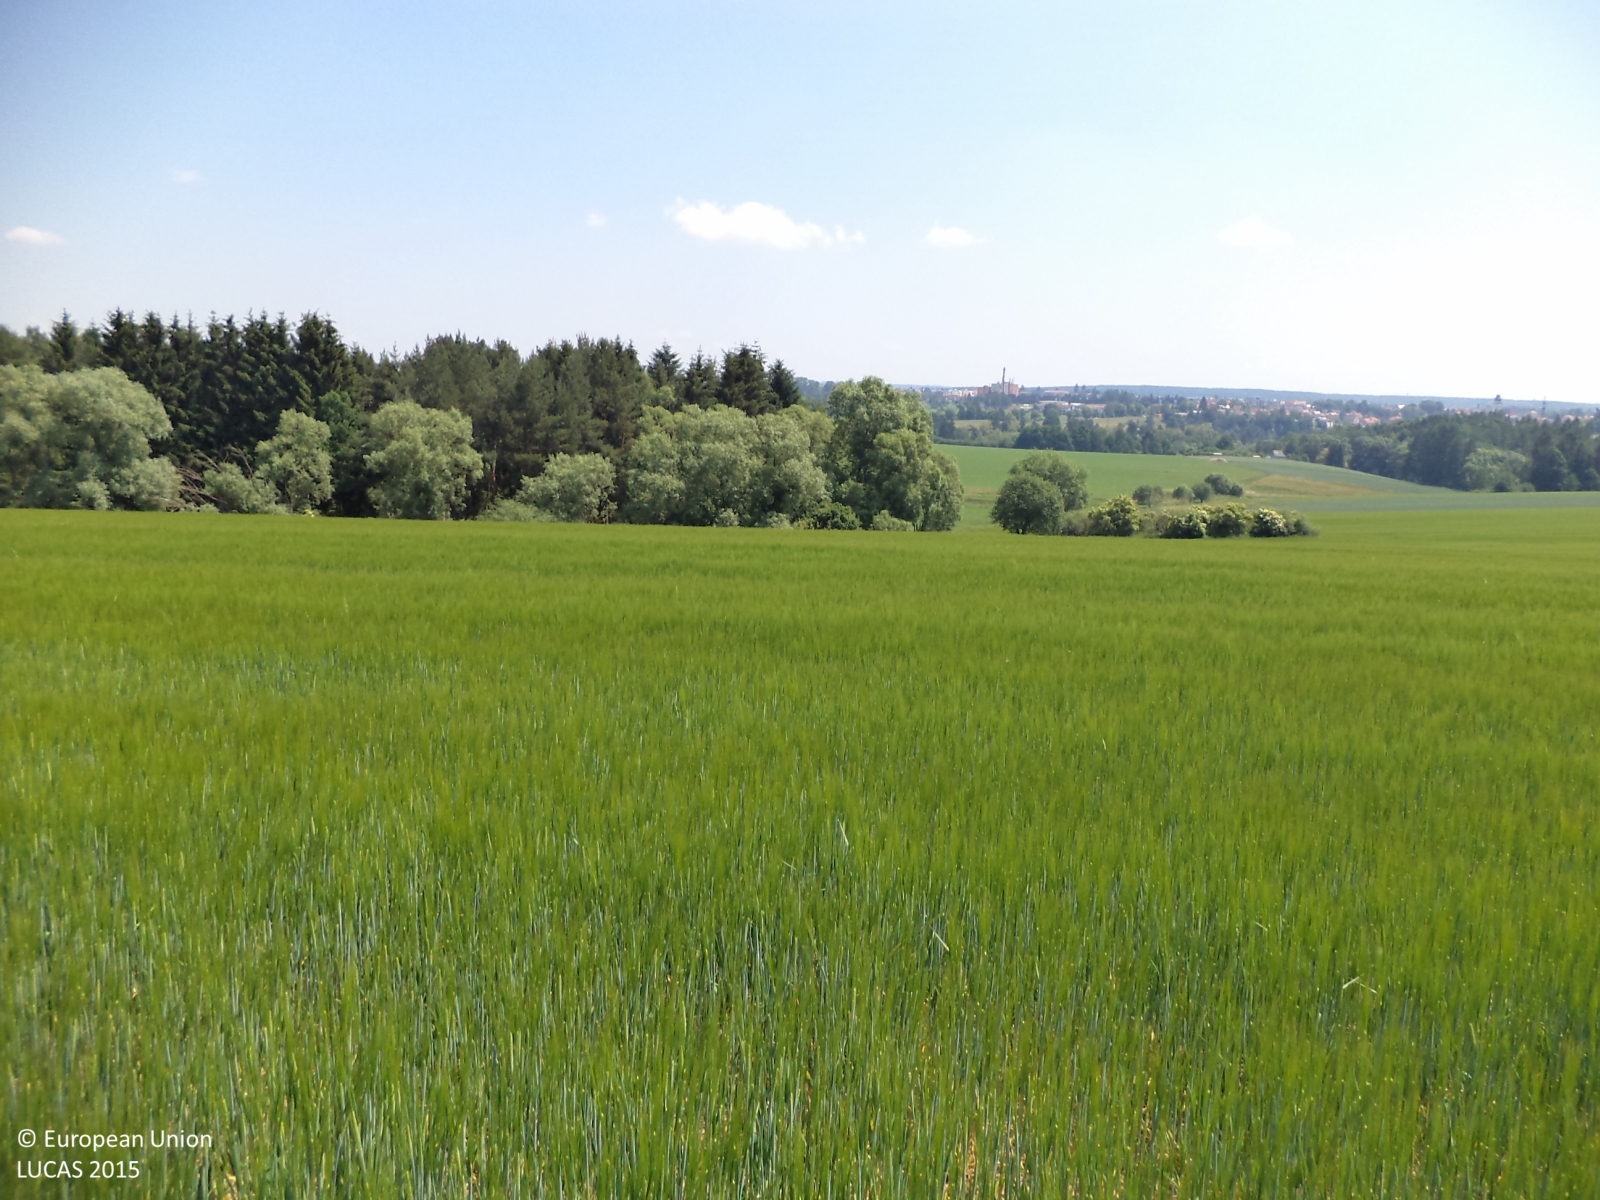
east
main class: Cropland
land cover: Barley
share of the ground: > 75 %
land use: Agriculture (excluding fallow land and kitchen gardens)
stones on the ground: < 10 %
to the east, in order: Barley; Other mixed woodland; Rivers and streams; Other mixed woodland; Clovers
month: June
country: CZ
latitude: 49.3052
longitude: 14.4436
